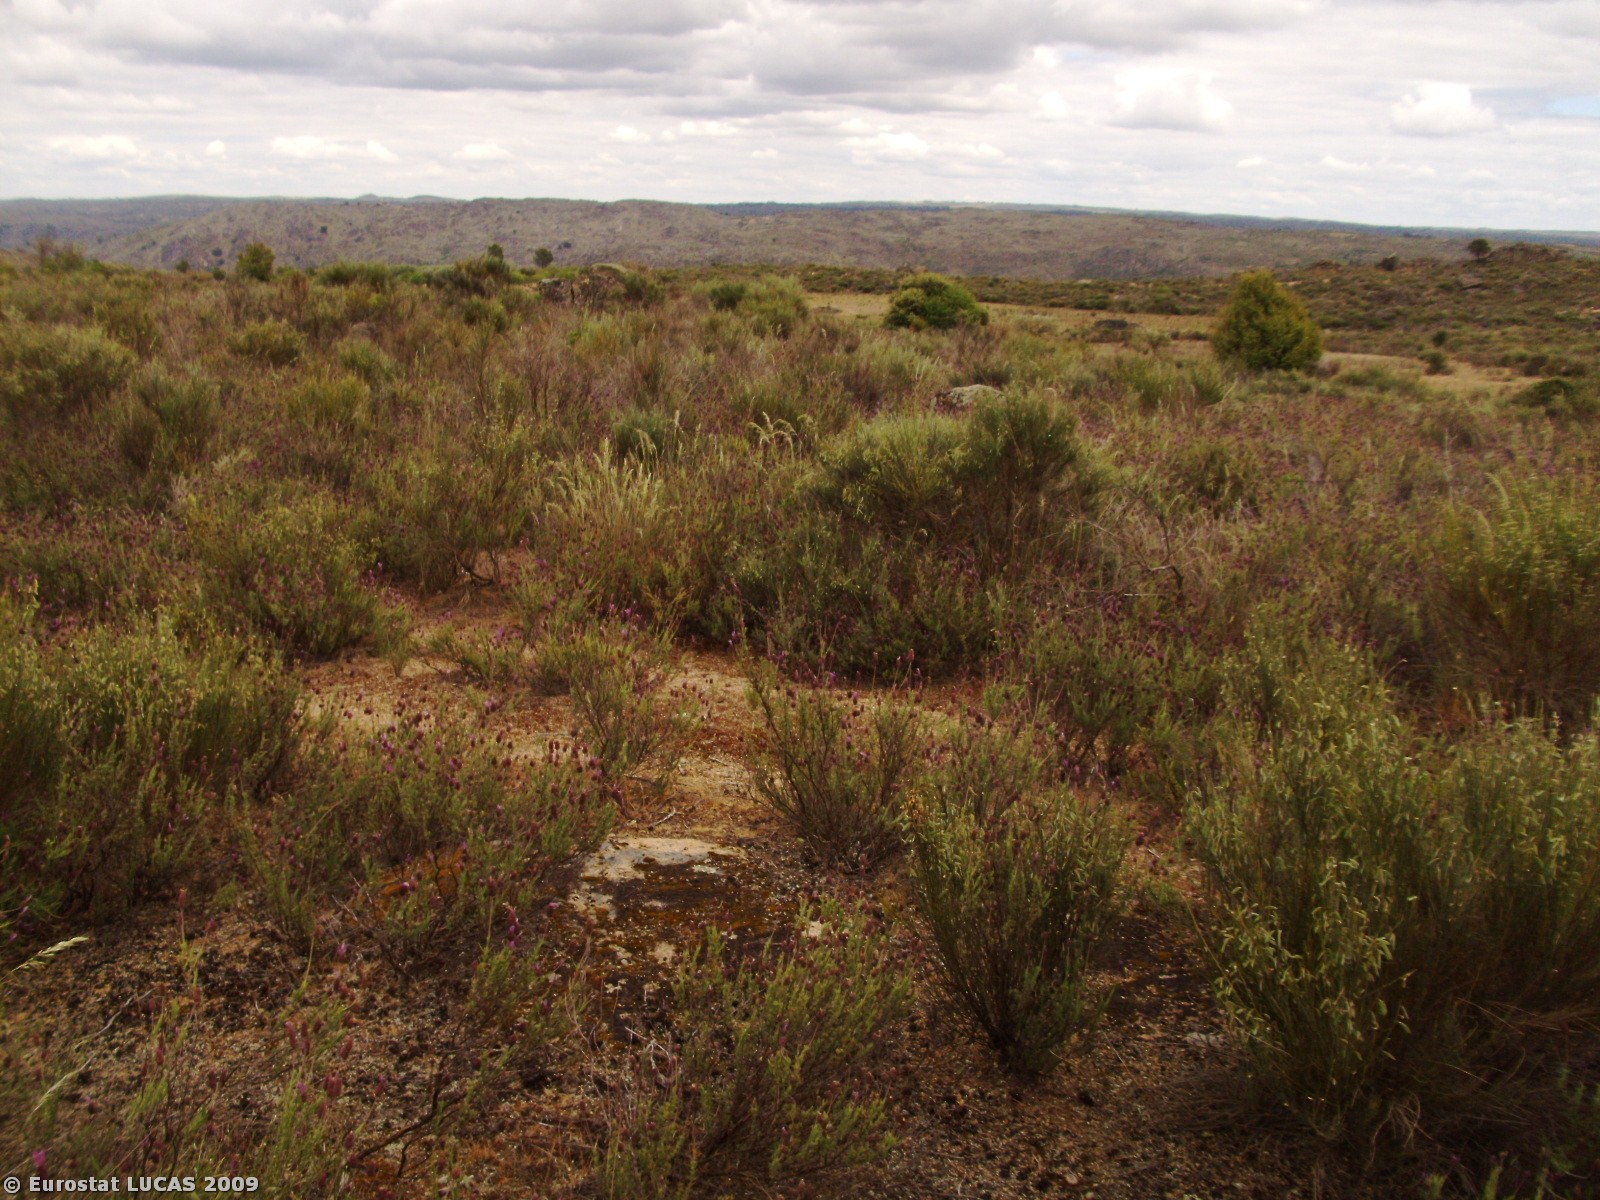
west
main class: Shrubland
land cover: Shrubland without tree cover
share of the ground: > 75 %
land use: Unused
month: May
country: PT
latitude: 40.9382
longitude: -7.1537
